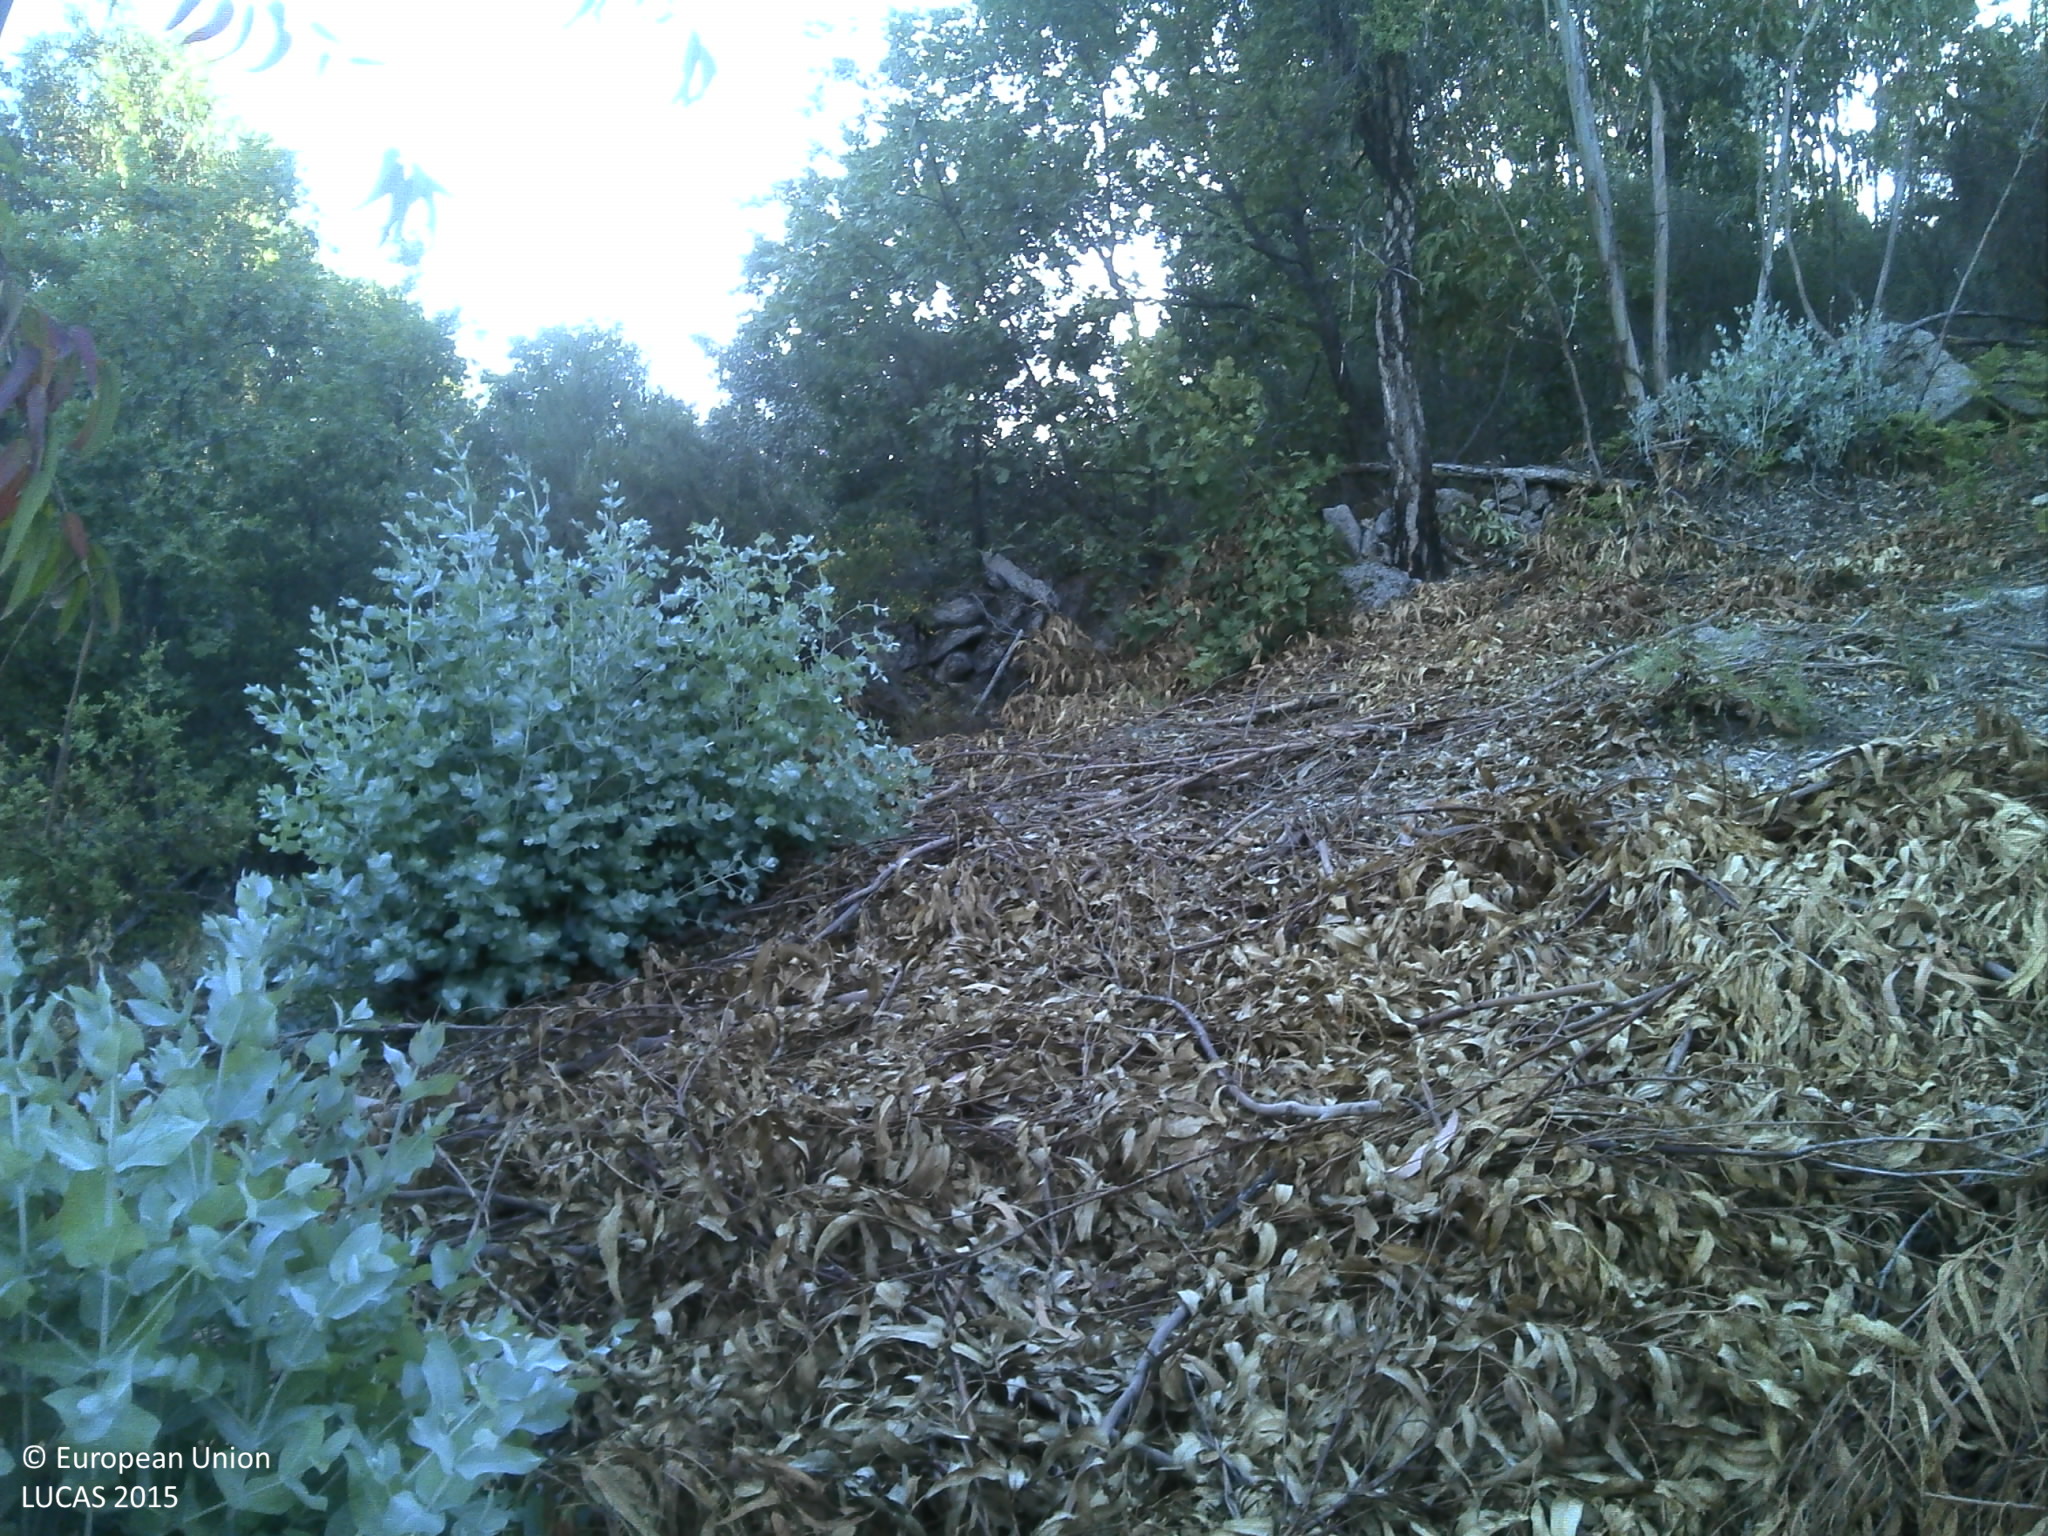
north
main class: Woodland
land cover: Broadleaved woodland
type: acidophilous oak and oak-birch forest
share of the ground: 25 - 50 %
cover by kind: broadleaved forest trees 45 %, consolidated bare surface 30 %, shrubs 15 %, unconsolidated bare surface 5 %
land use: Forestry
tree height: > 5 m
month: June
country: PT
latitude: 40.1025
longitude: -7.1884
